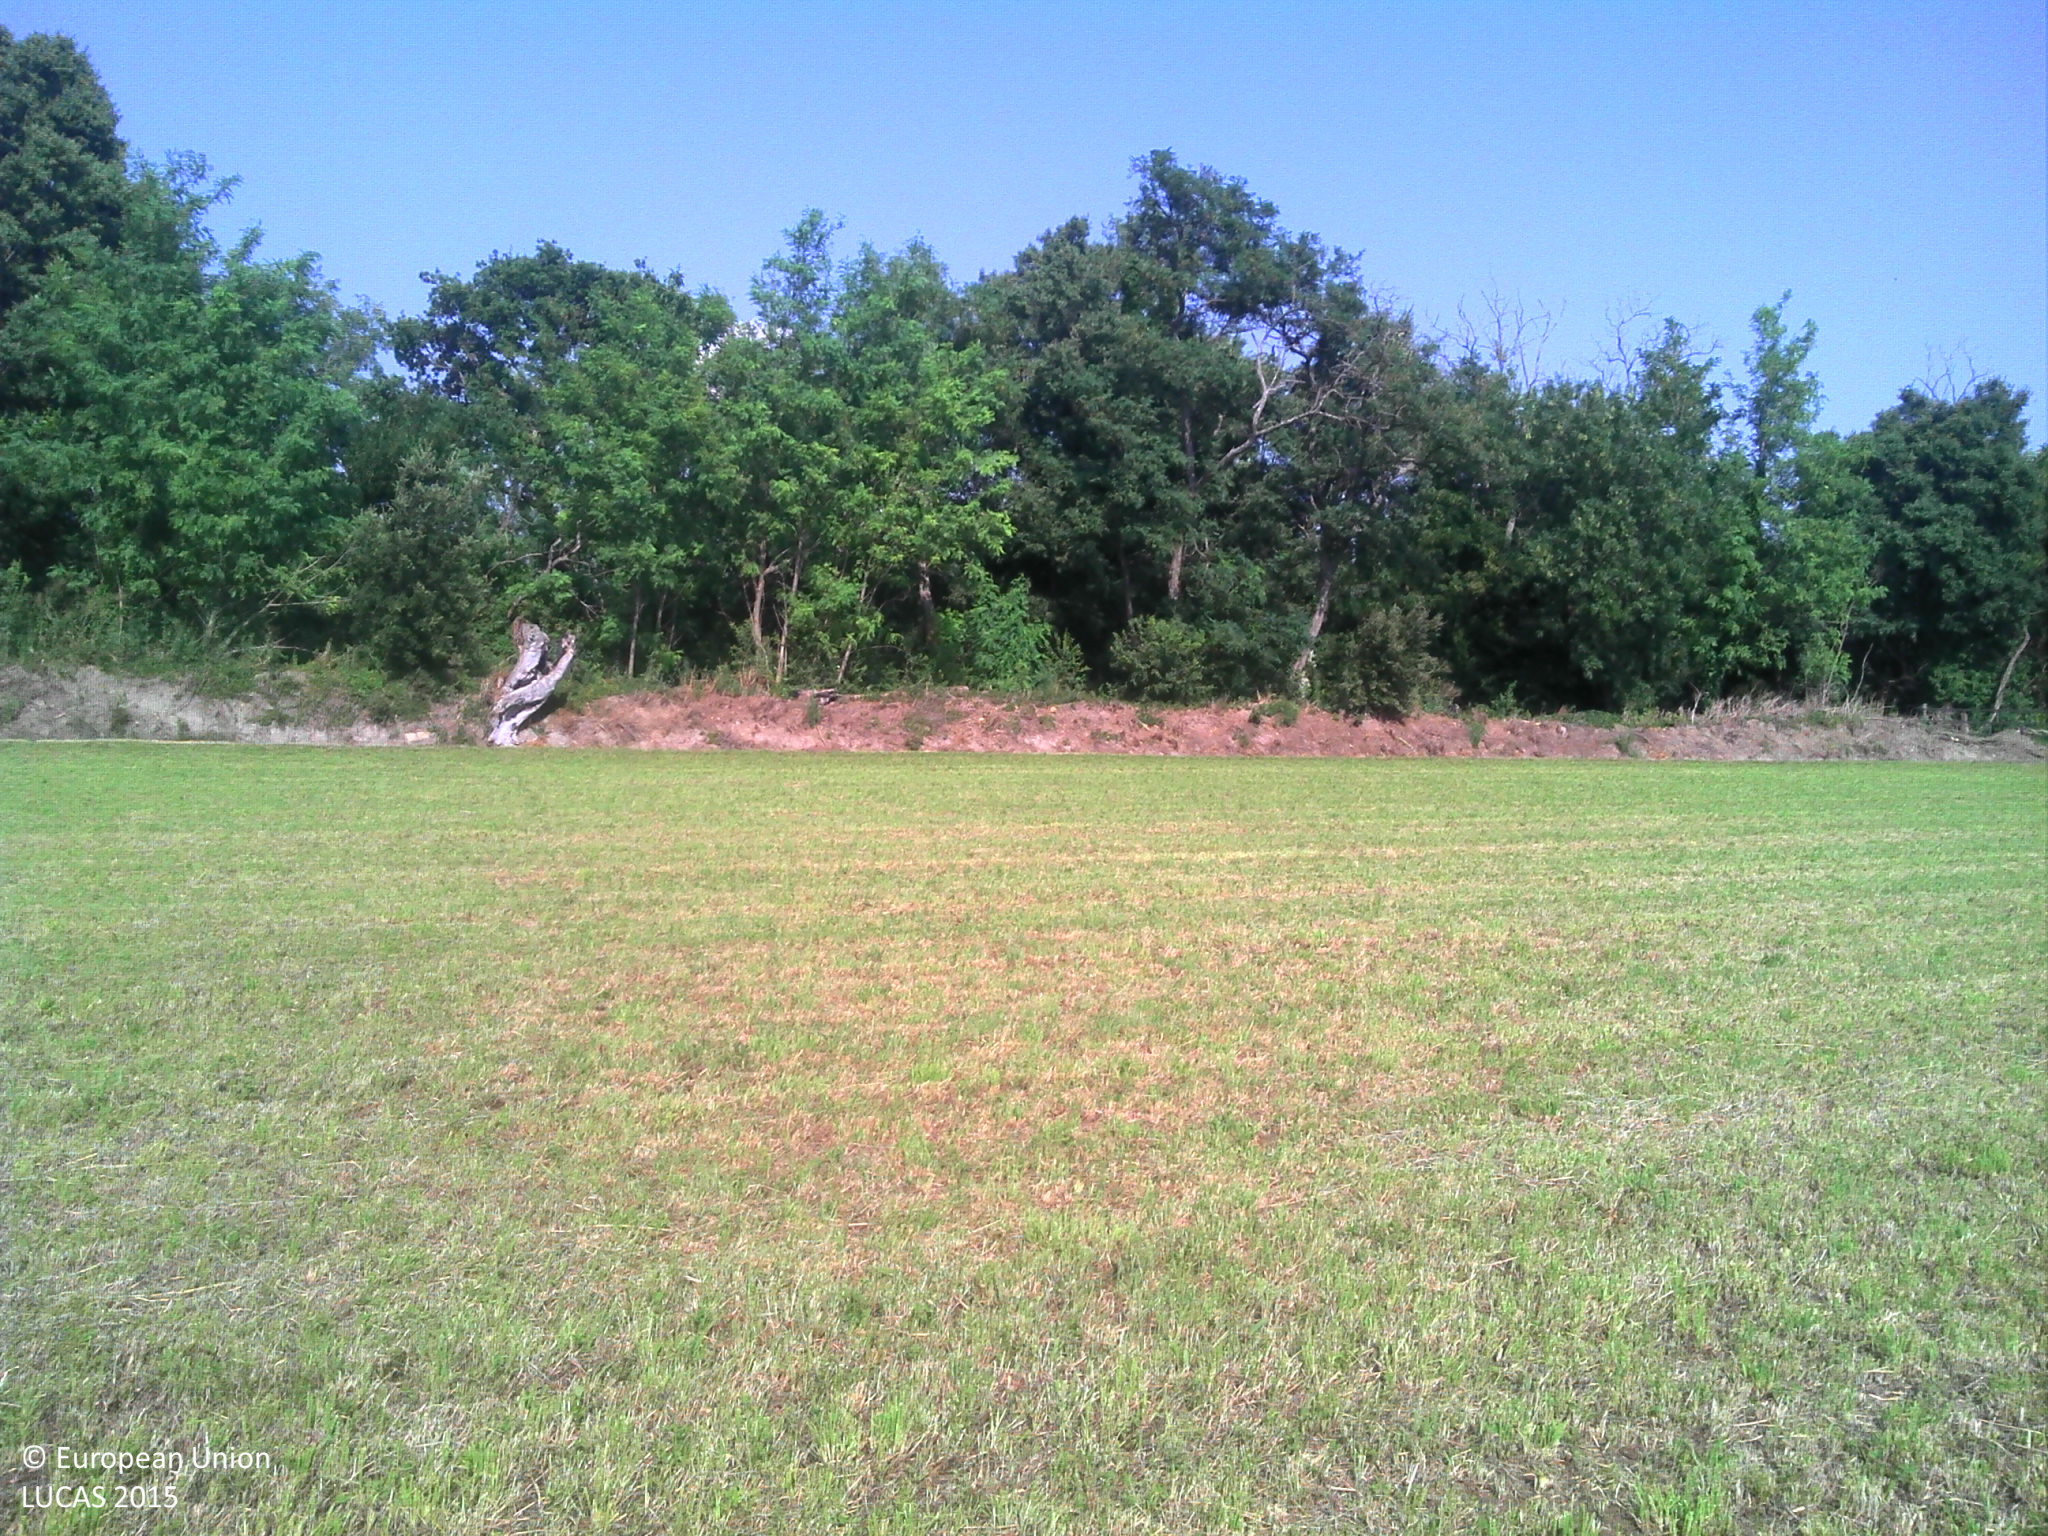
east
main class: Grassland
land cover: Grassland without tree/shrub cover
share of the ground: > 75 %
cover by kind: herbaceous plants 100 %
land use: Agriculture (excluding fallow land and kitchen gardens)
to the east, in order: Grassland without tree/shrub cover; Ditches and canals; Lines of trees; Grassland without tree/shrub cover; Ditches and canals; Lines of trees; Grassland without tree/shrub cover
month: July
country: FR
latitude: 43.6728
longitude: 5.0607
